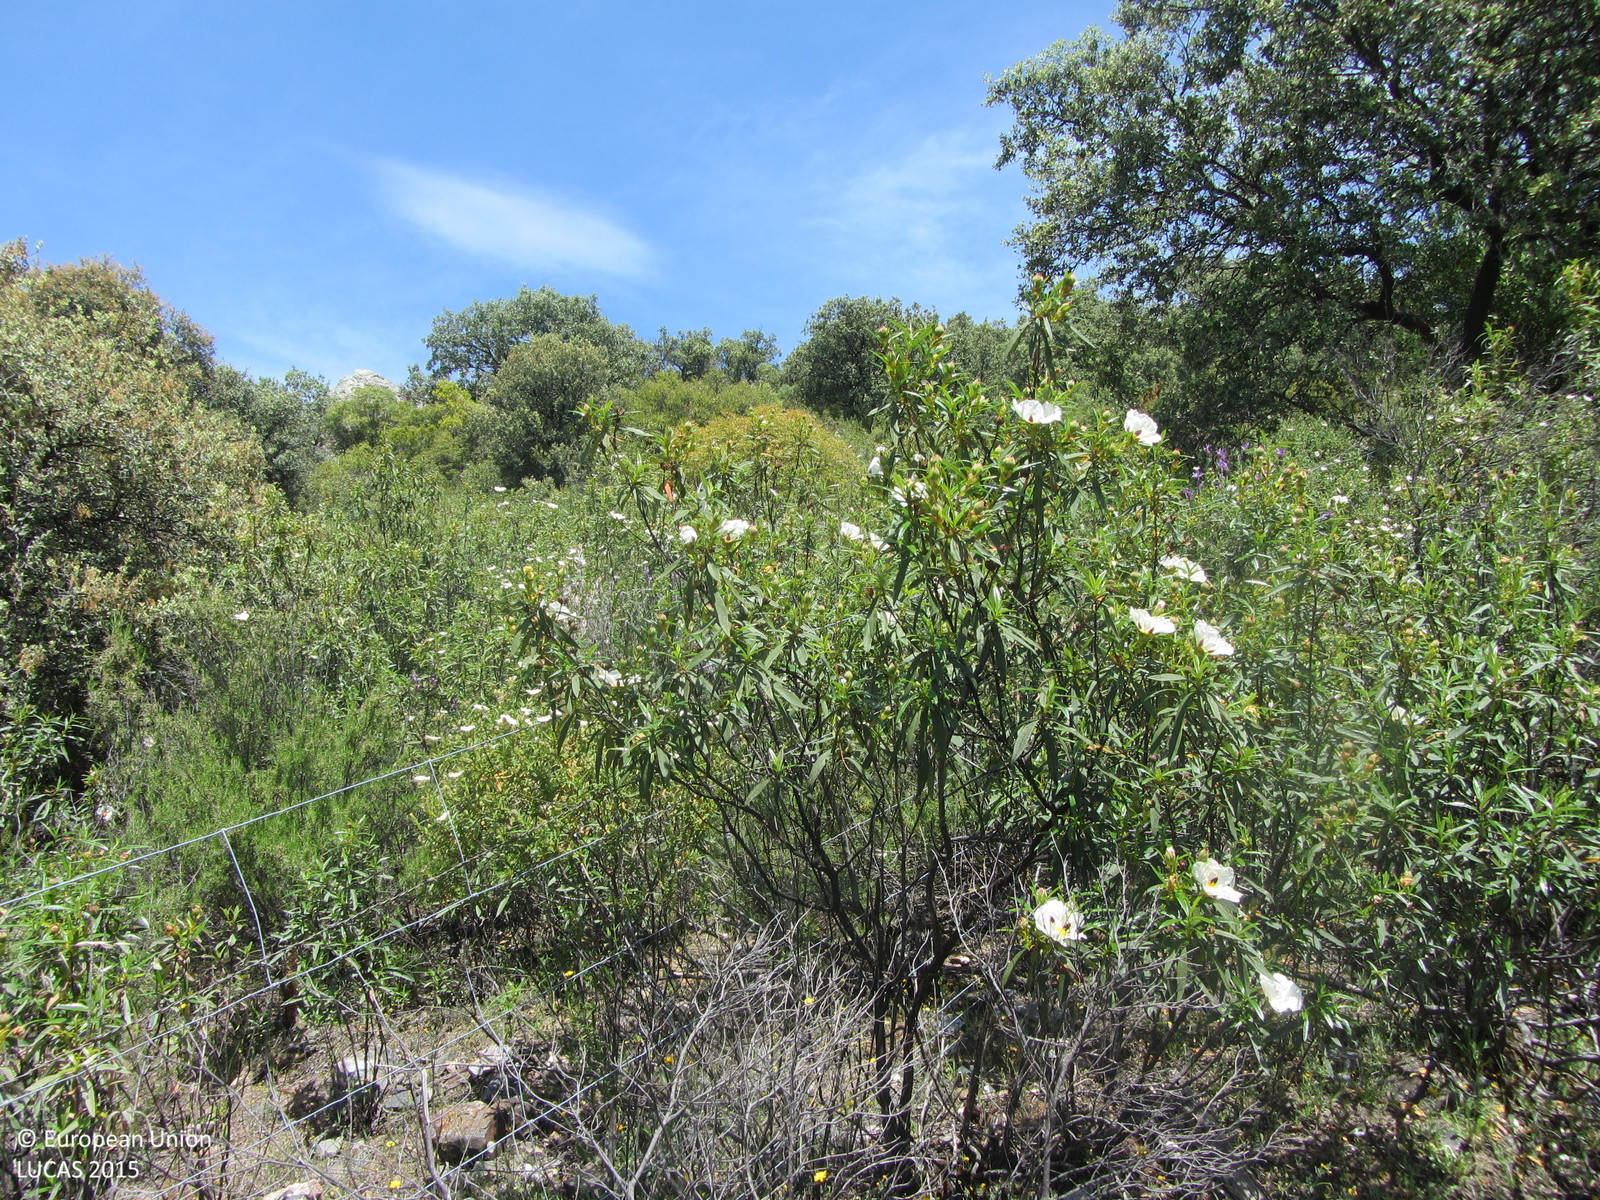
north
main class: Shrubland
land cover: Shrubland with sparse tree cover
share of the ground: 10 - 25 %
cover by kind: herbaceous plants 35 %, consolidated bare surface 35 %, shrubs 25 %, broadleaved forest trees 5 %
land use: Semi-natural and natural areas not in use
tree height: < 5 m
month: May
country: ES
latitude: 38.3350
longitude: -3.0088
